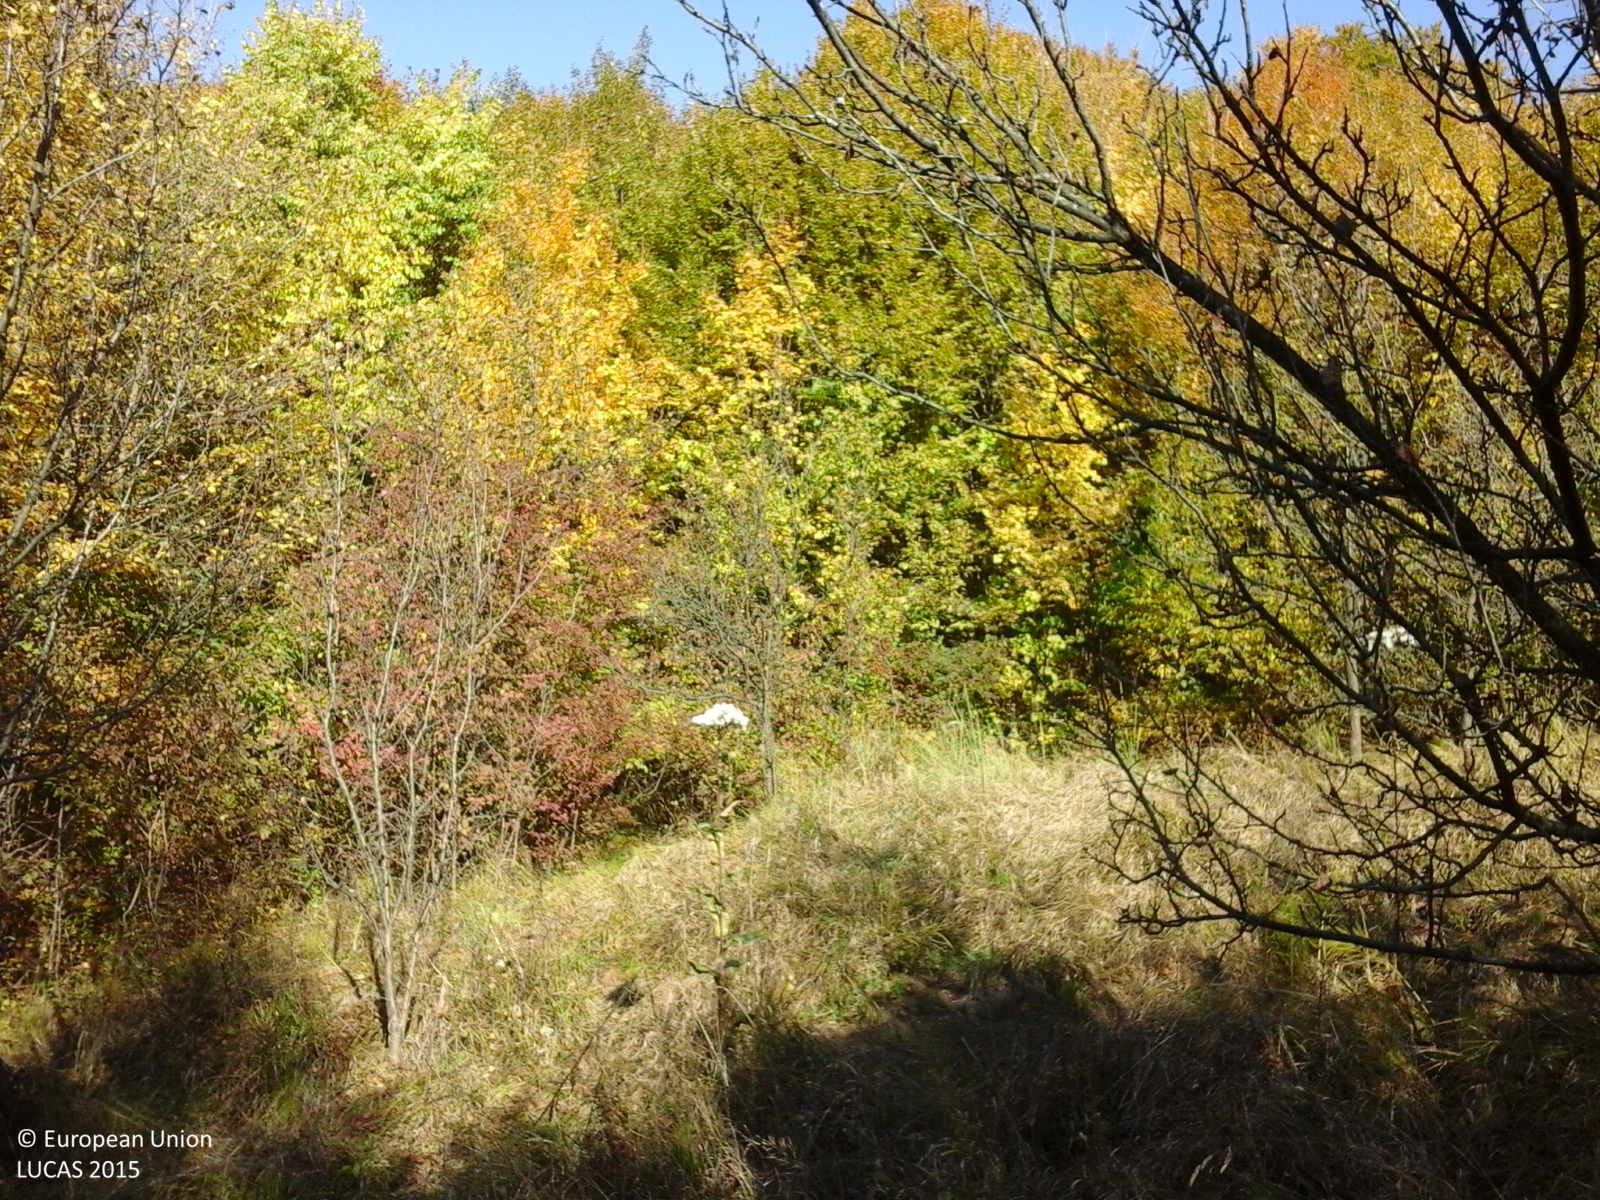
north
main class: Grassland
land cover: Grassland with sparse tree/shrub cover
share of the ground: > 75 %
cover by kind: herbaceous plants 85 %, shrubs 10 %, broadleaved forest trees 5 %
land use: Fallow land
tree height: < 5 m
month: October
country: RO
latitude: 45.1069
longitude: 26.4262
